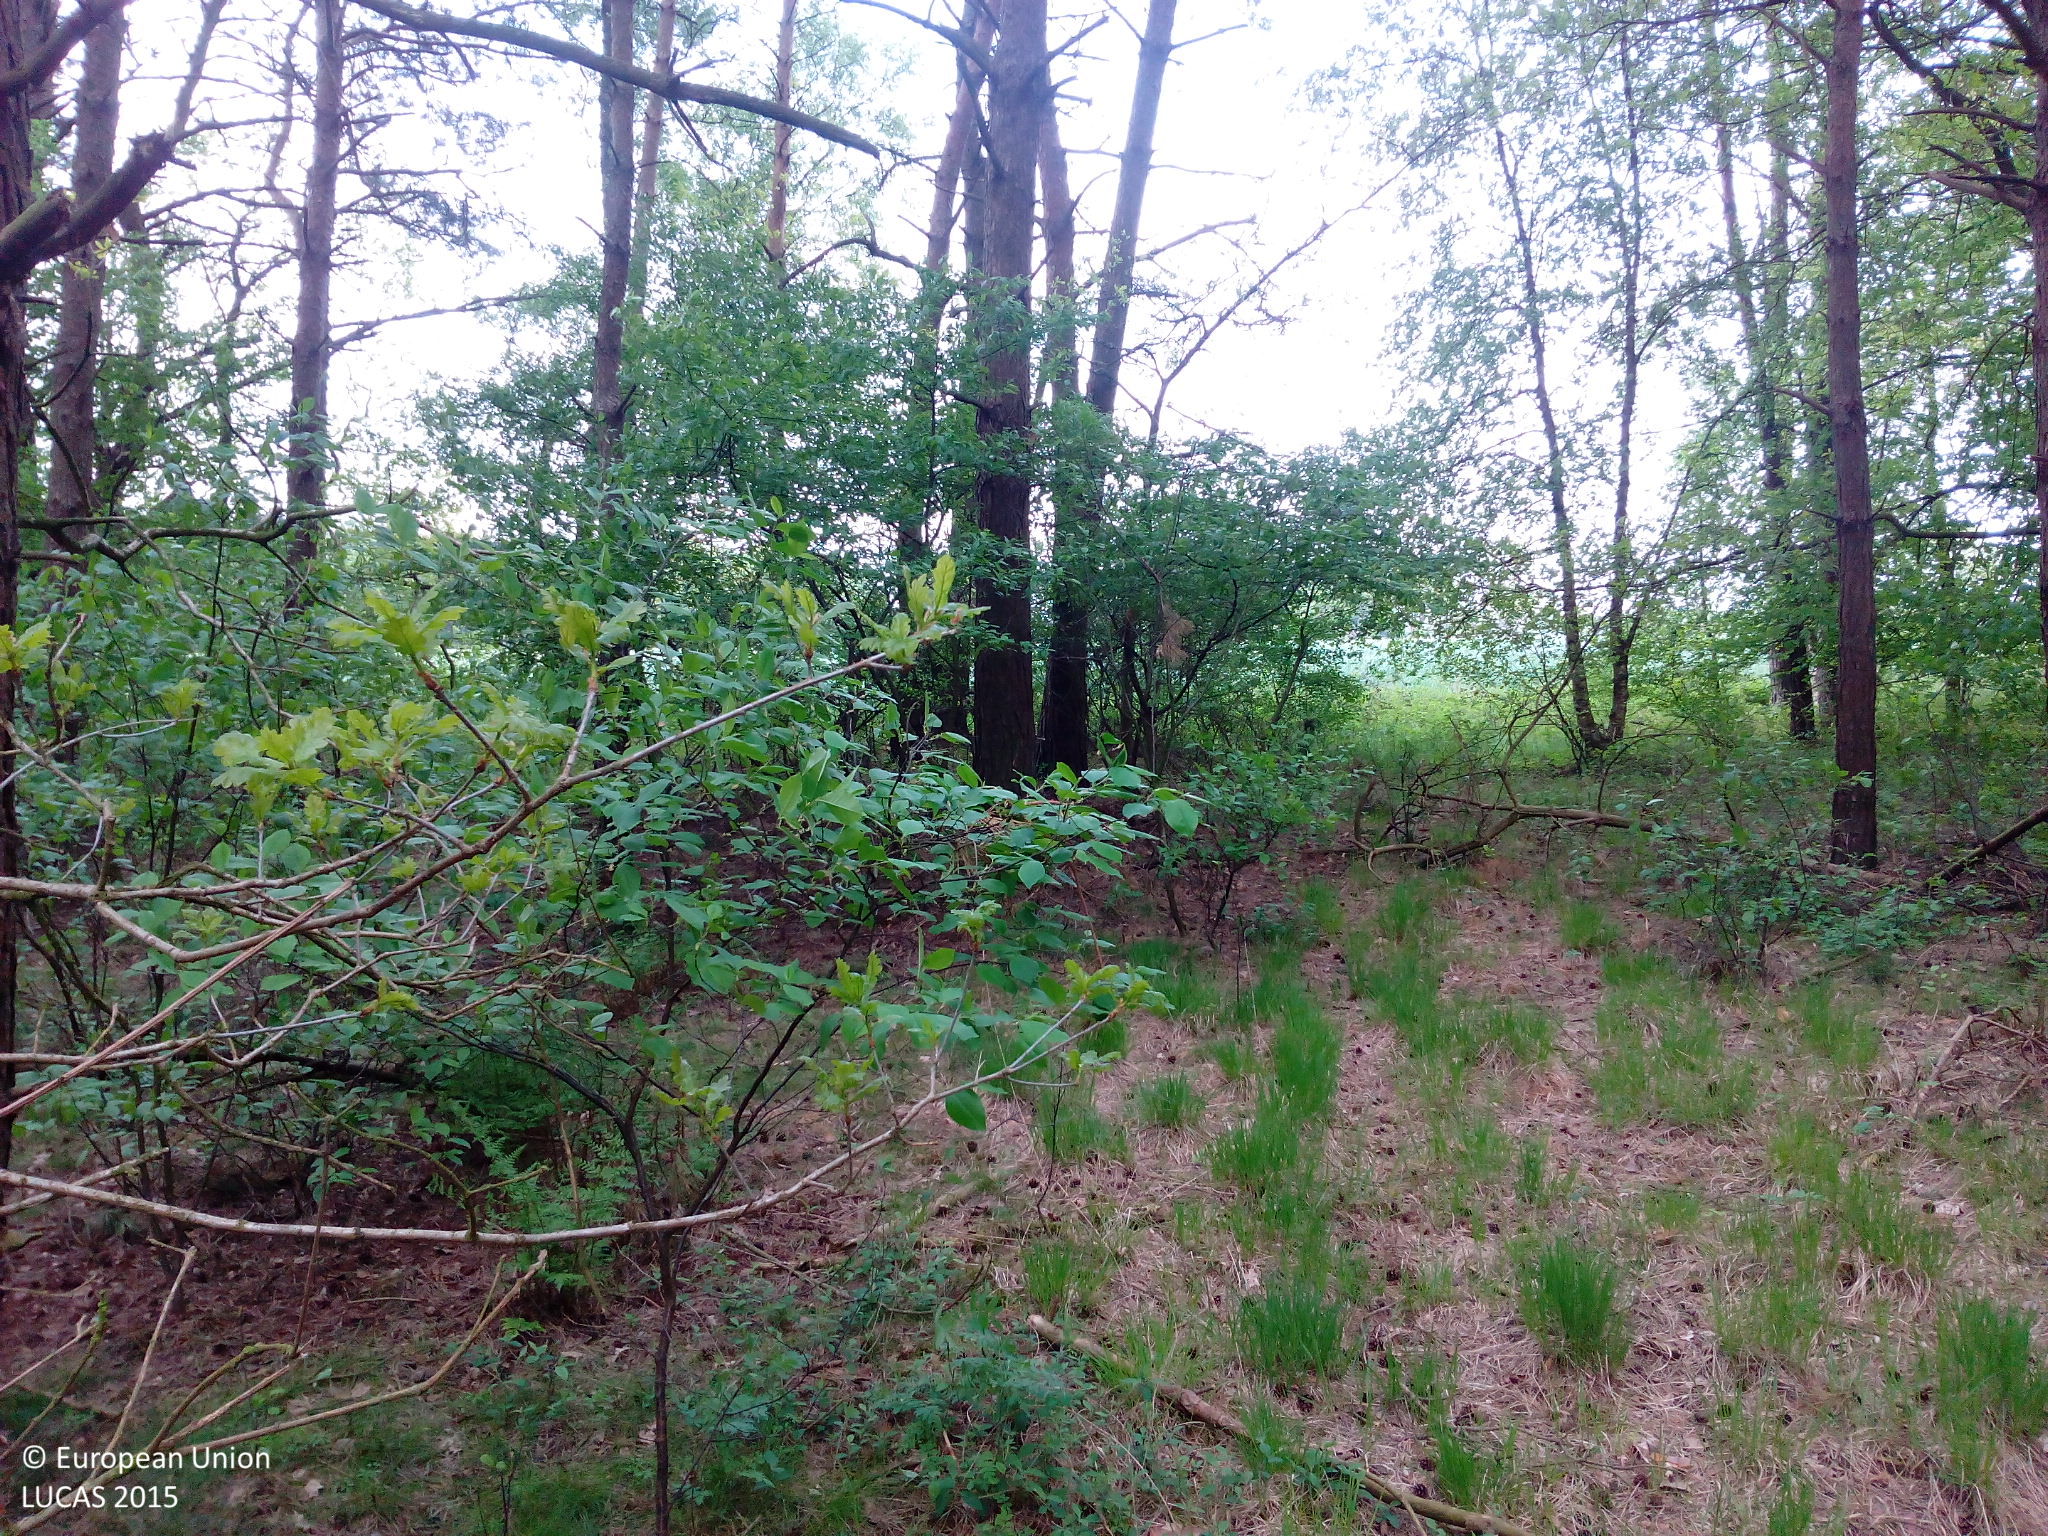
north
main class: Woodland
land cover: Pine dominated mixed woodland
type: hemiboreal forest and nemoral coniferous forest and mixed broadleaved-coniferous forest
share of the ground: > 75 %
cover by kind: coniferous forest trees 60 %, broadleaved forest trees 30 %, shrubs 5 %, herbaceous plants 5 %
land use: Forestry
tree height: > 5 m
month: May
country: DE
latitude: 53.1477
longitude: 9.2079
